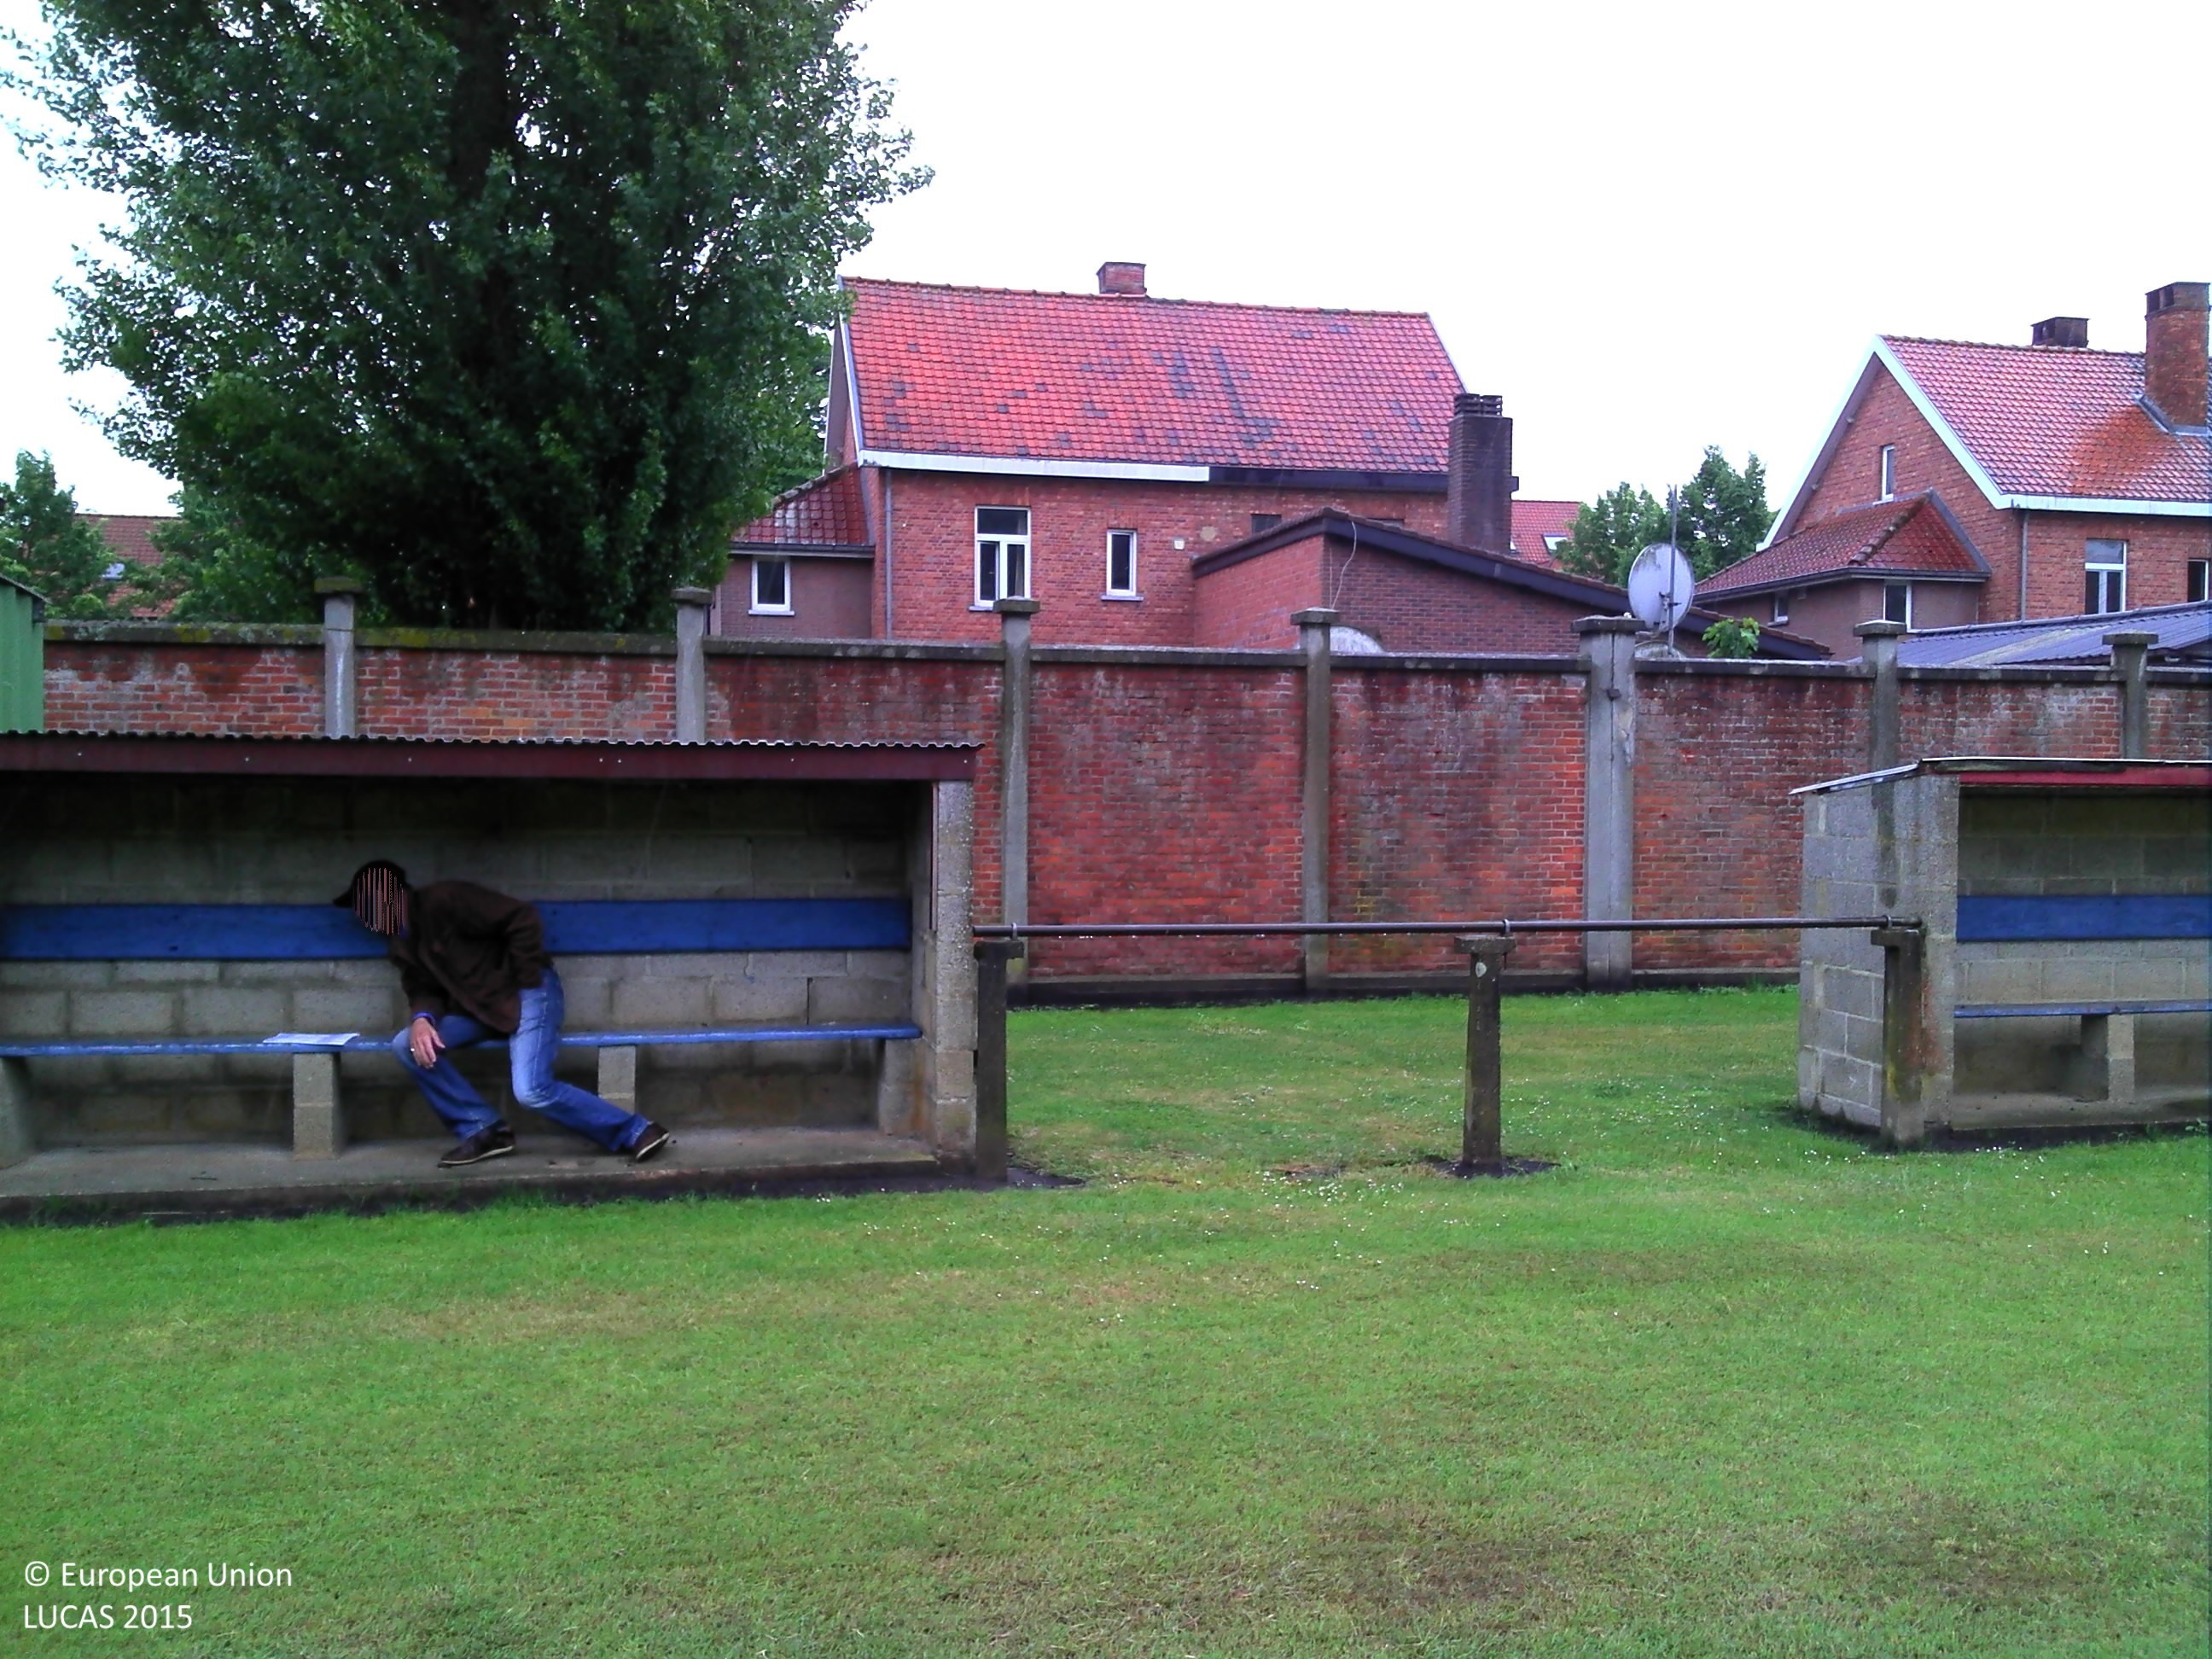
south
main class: Grassland
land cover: Grassland without tree/shrub cover
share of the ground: > 75 %
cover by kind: herbaceous plants 100 %
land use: Sport
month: June
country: BE
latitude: 51.0746
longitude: 5.2162
